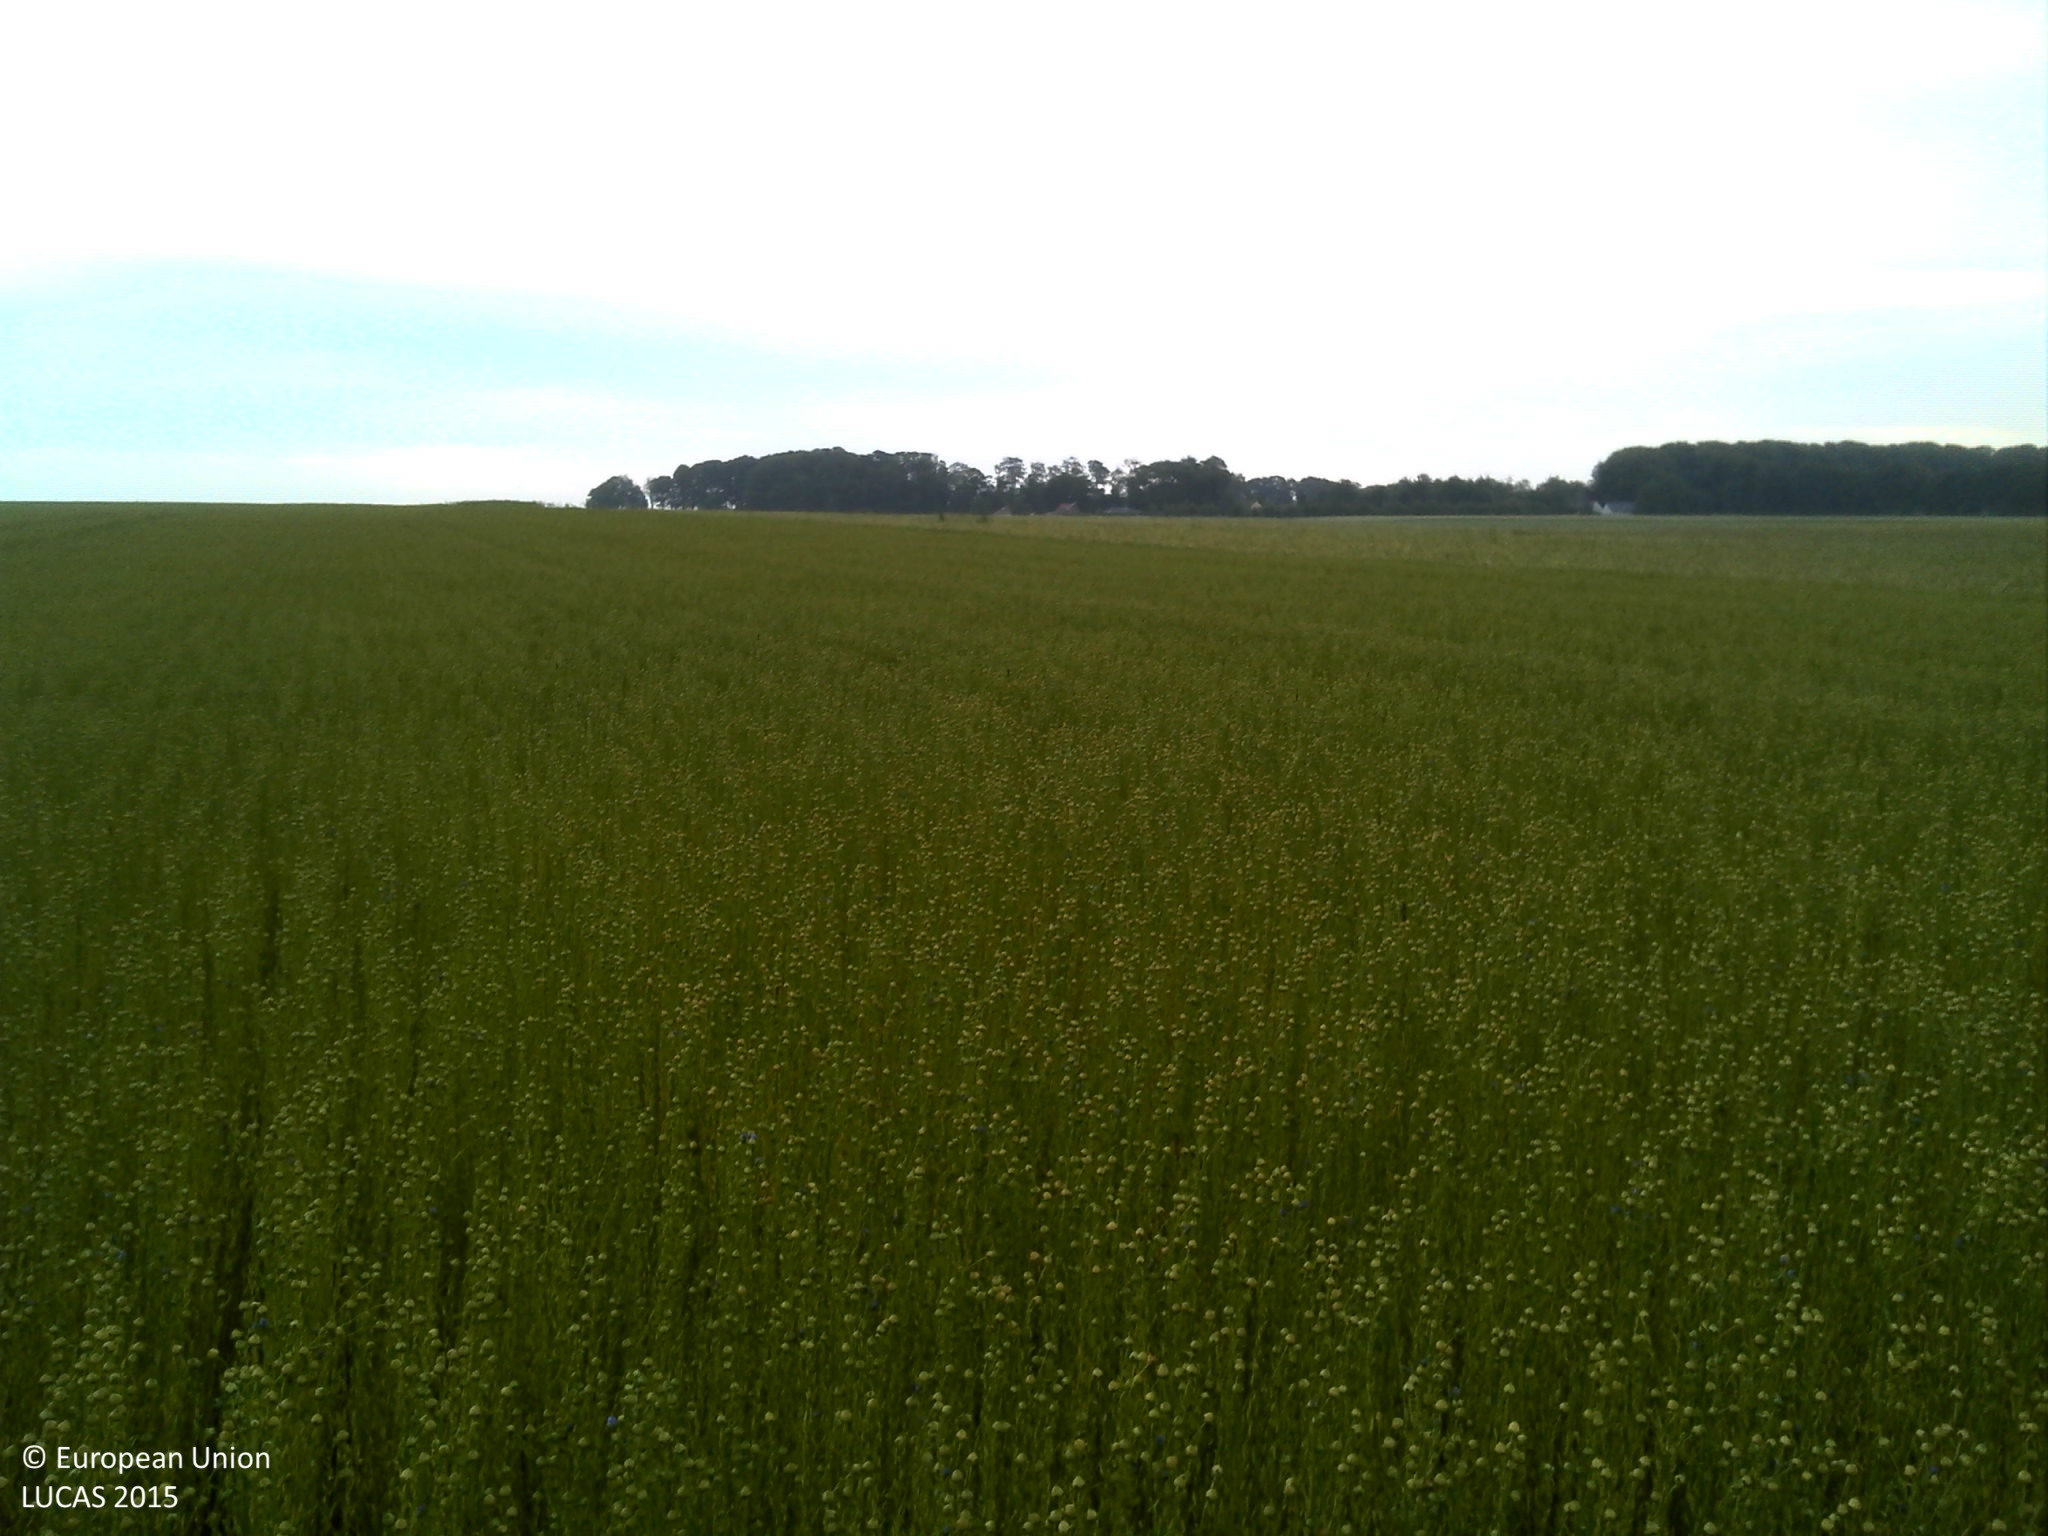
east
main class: Cropland
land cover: Other fibre and oleaginous crops
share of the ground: > 75 %
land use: Agriculture (excluding fallow land and kitchen gardens)
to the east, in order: Other fibre and oleaginous crops; Oats; Common wheat; Durum wheat; Common wheat
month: July
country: FR
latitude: 49.8843
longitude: 1.0285
